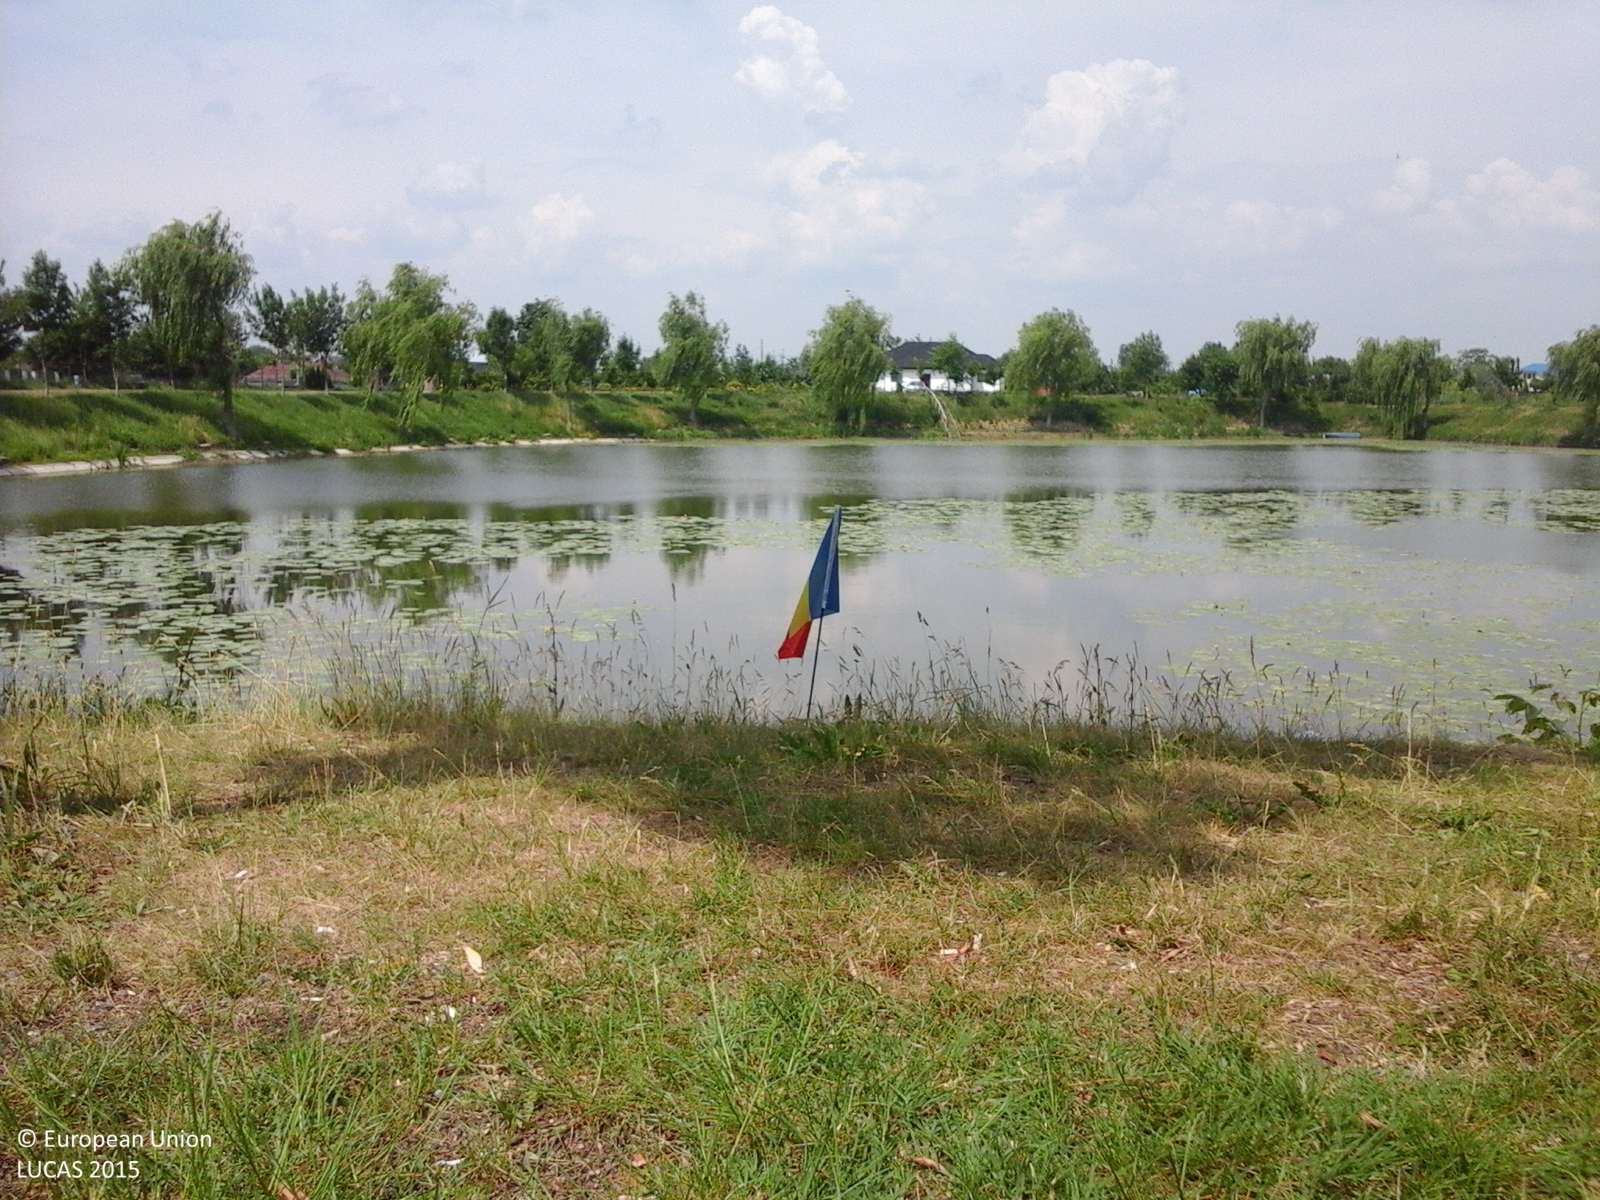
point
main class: Grassland
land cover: Grassland with sparse tree/shrub cover
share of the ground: > 75 %
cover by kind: herbaceous plants 90 %, broadleaved forest trees 5 %, shrubs 5 %
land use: Amenities, museums, leisure
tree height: > 5 m
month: June
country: RO
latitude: 46.9307
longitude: 26.9759
